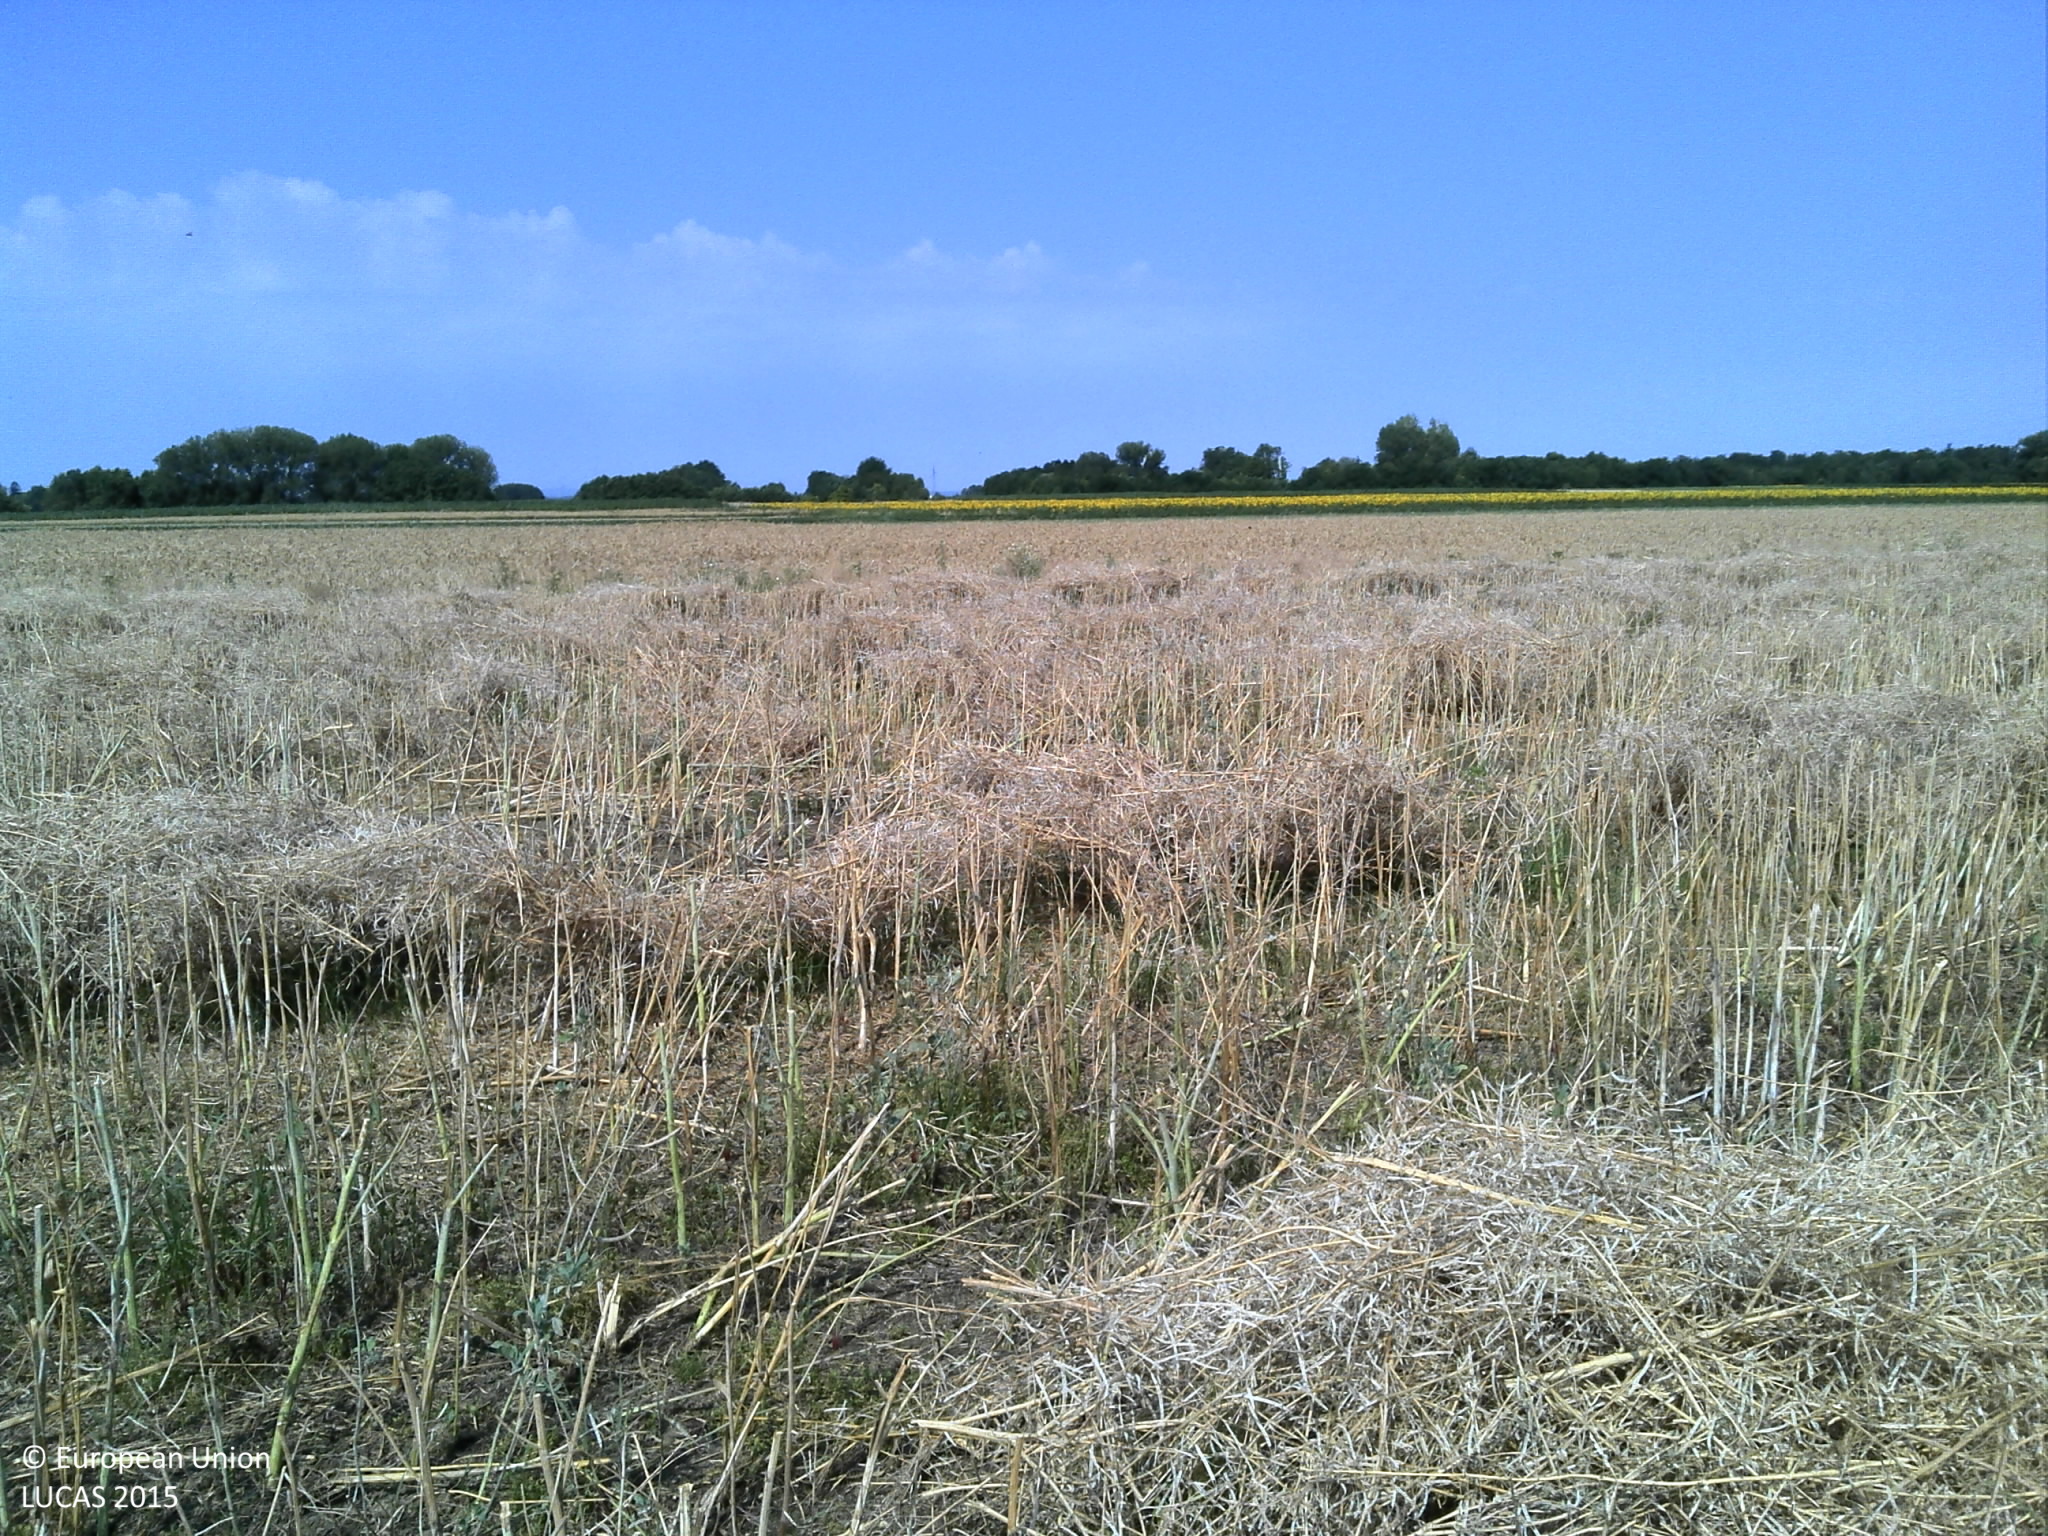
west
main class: Cropland
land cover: Rape and turnip rape
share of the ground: > 75 %
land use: Agriculture (excluding fallow land and kitchen gardens)
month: July
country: HR
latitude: 45.3587
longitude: 18.5206
